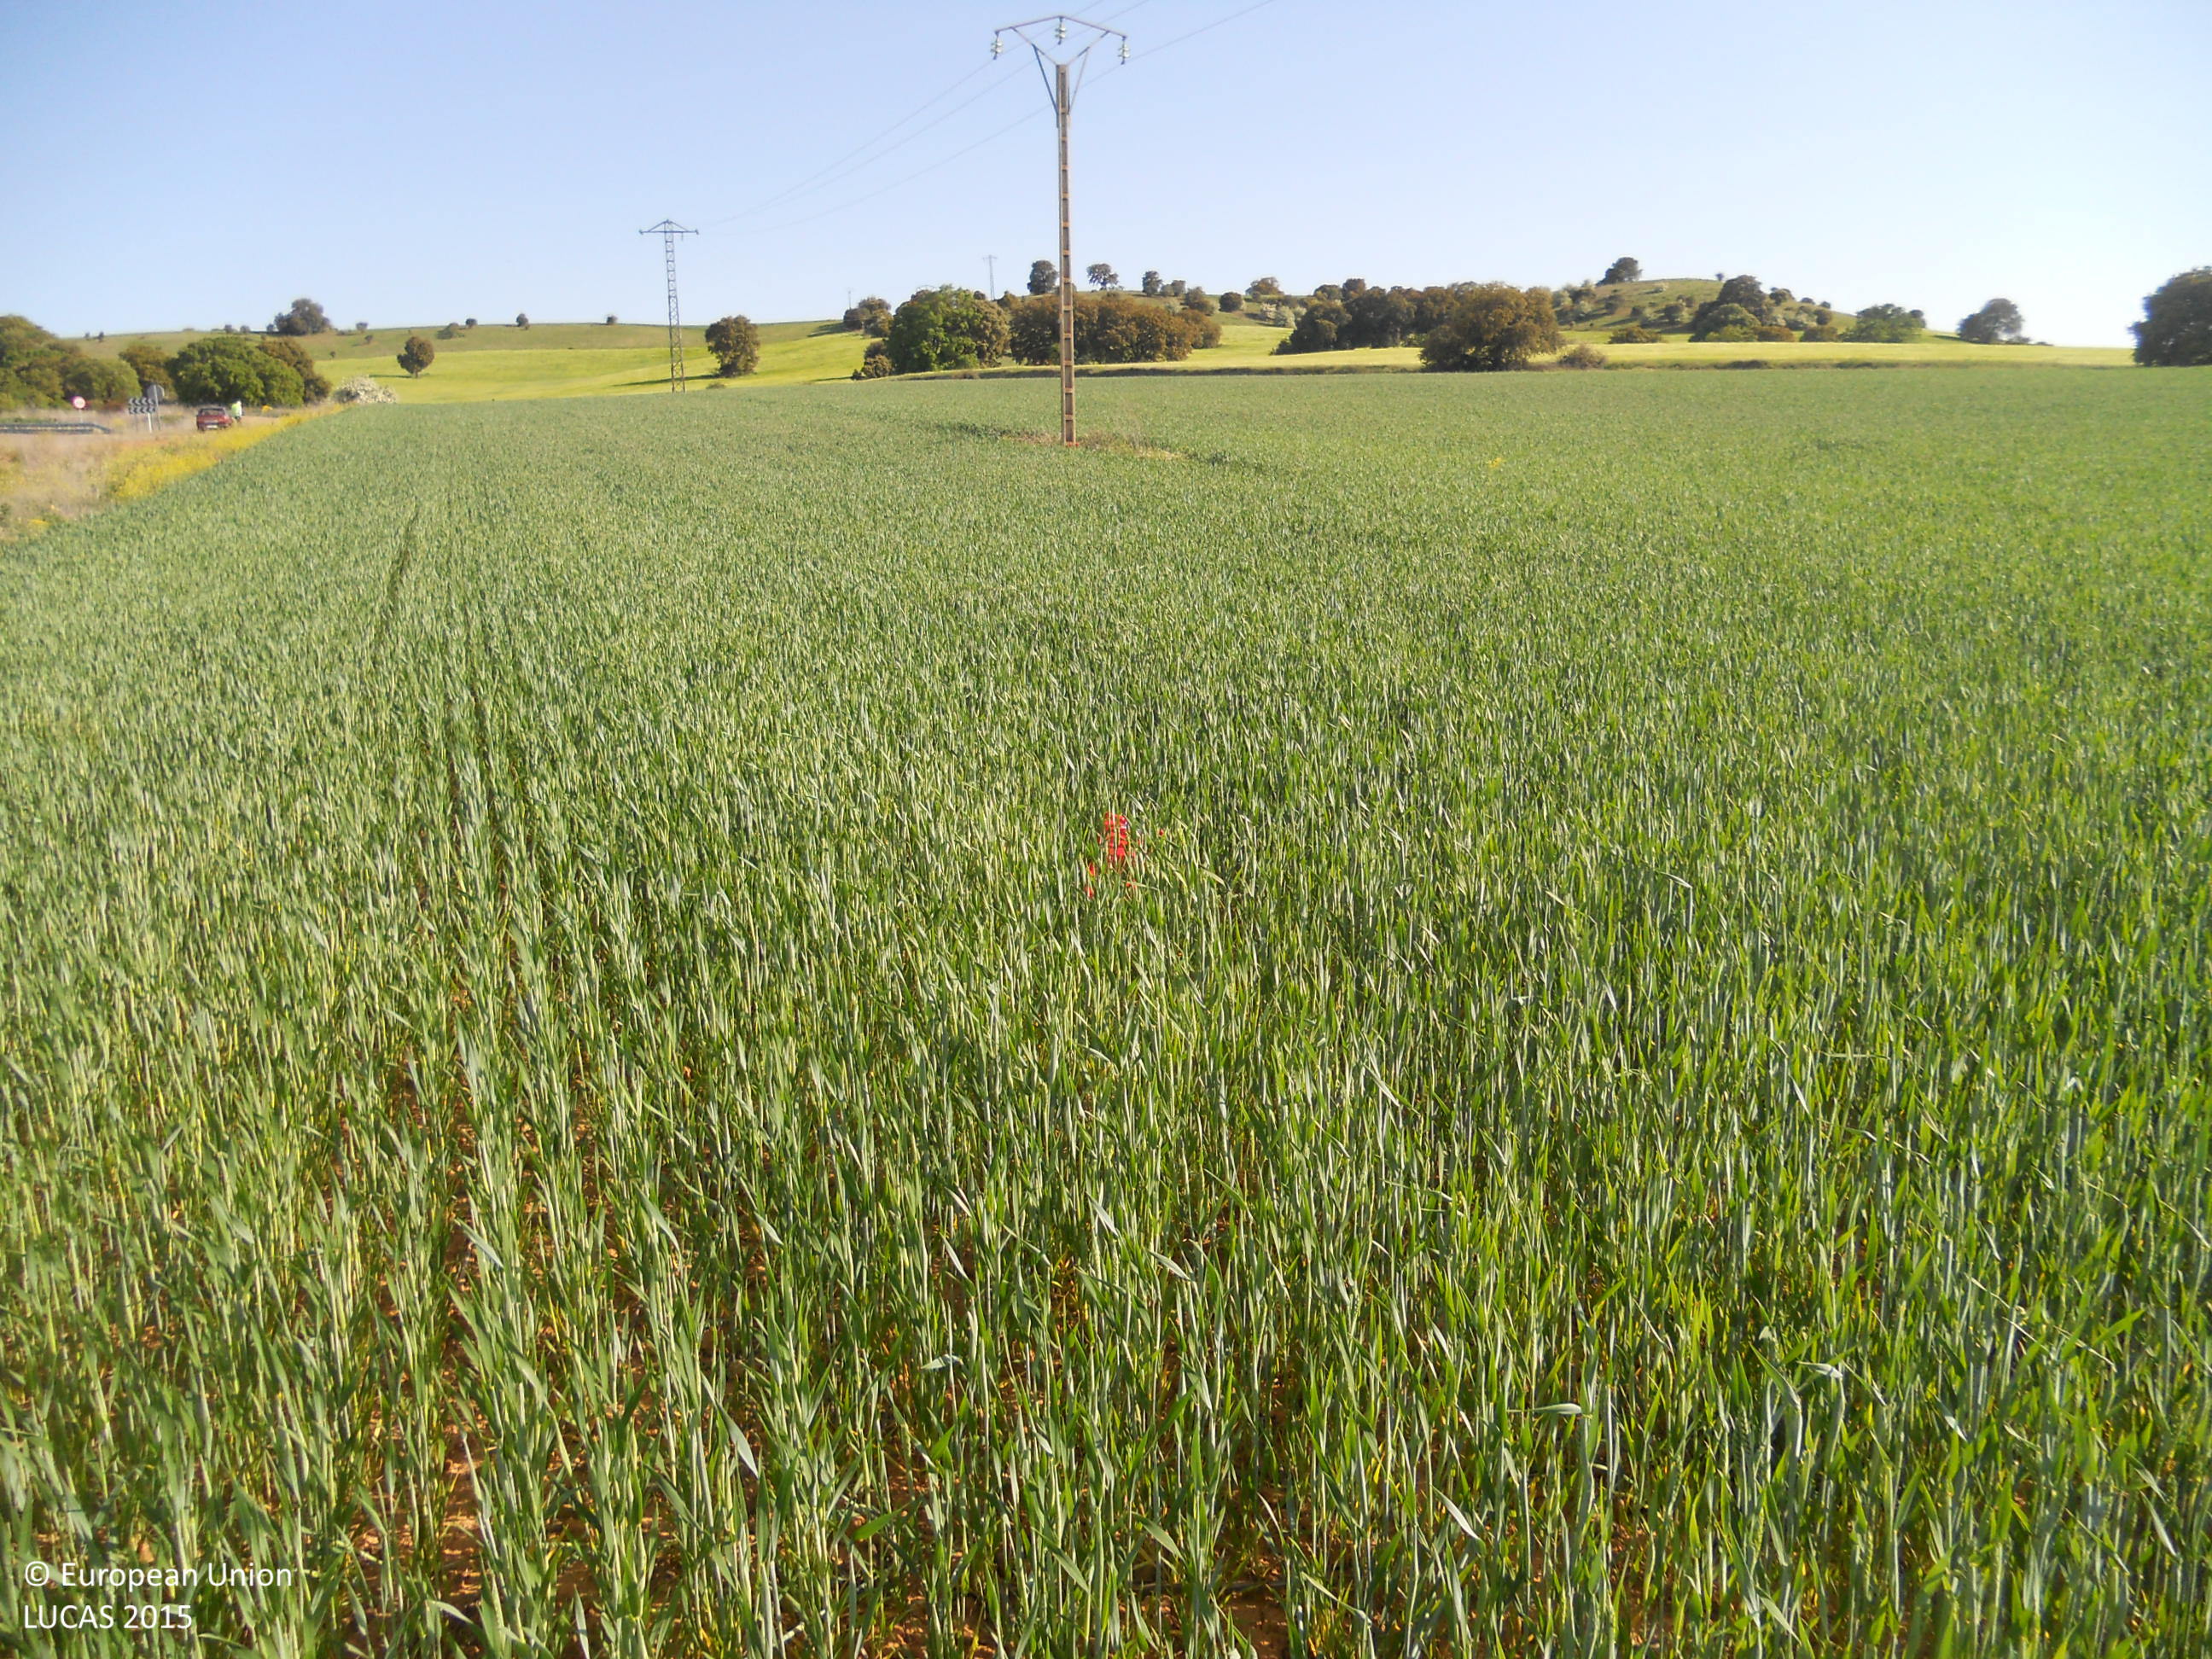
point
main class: Cropland
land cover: Common wheat
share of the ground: > 75 %
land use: Agriculture (excluding fallow land and kitchen gardens)
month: May
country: ES
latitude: 42.2426
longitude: -5.4943
